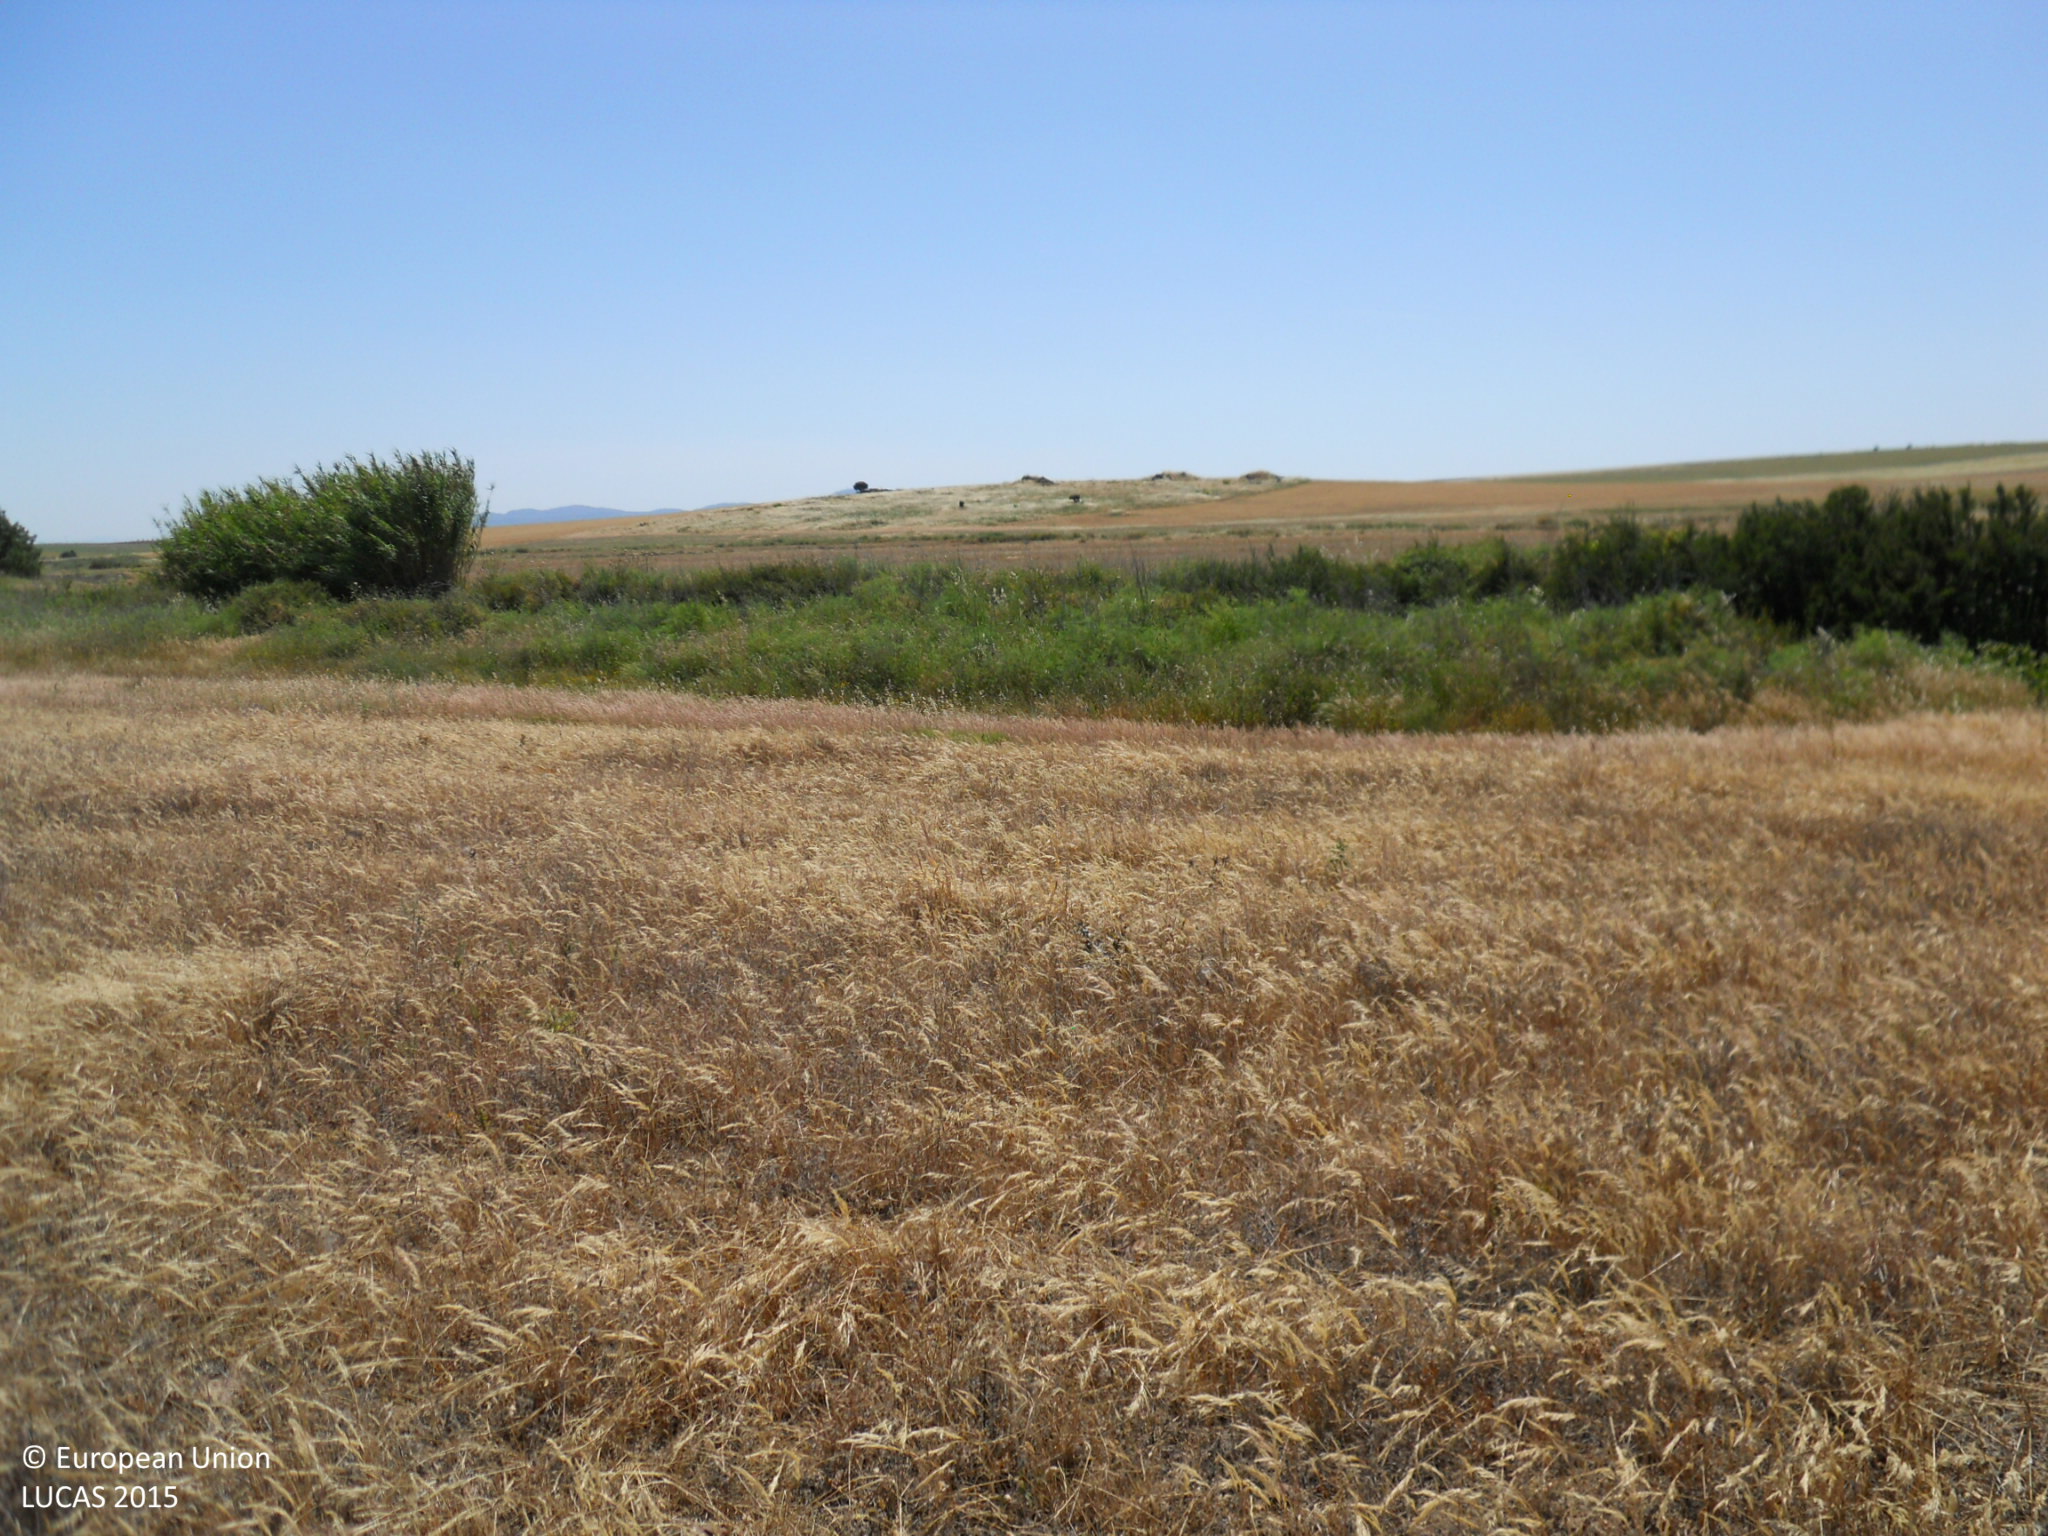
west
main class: Grassland
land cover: Grassland without tree/shrub cover
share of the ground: 50 - 75 %
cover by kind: herbaceous plants 100 %
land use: Agriculture (excluding fallow land and kitchen gardens)
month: May
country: ES
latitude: 38.9719
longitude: -6.2740
